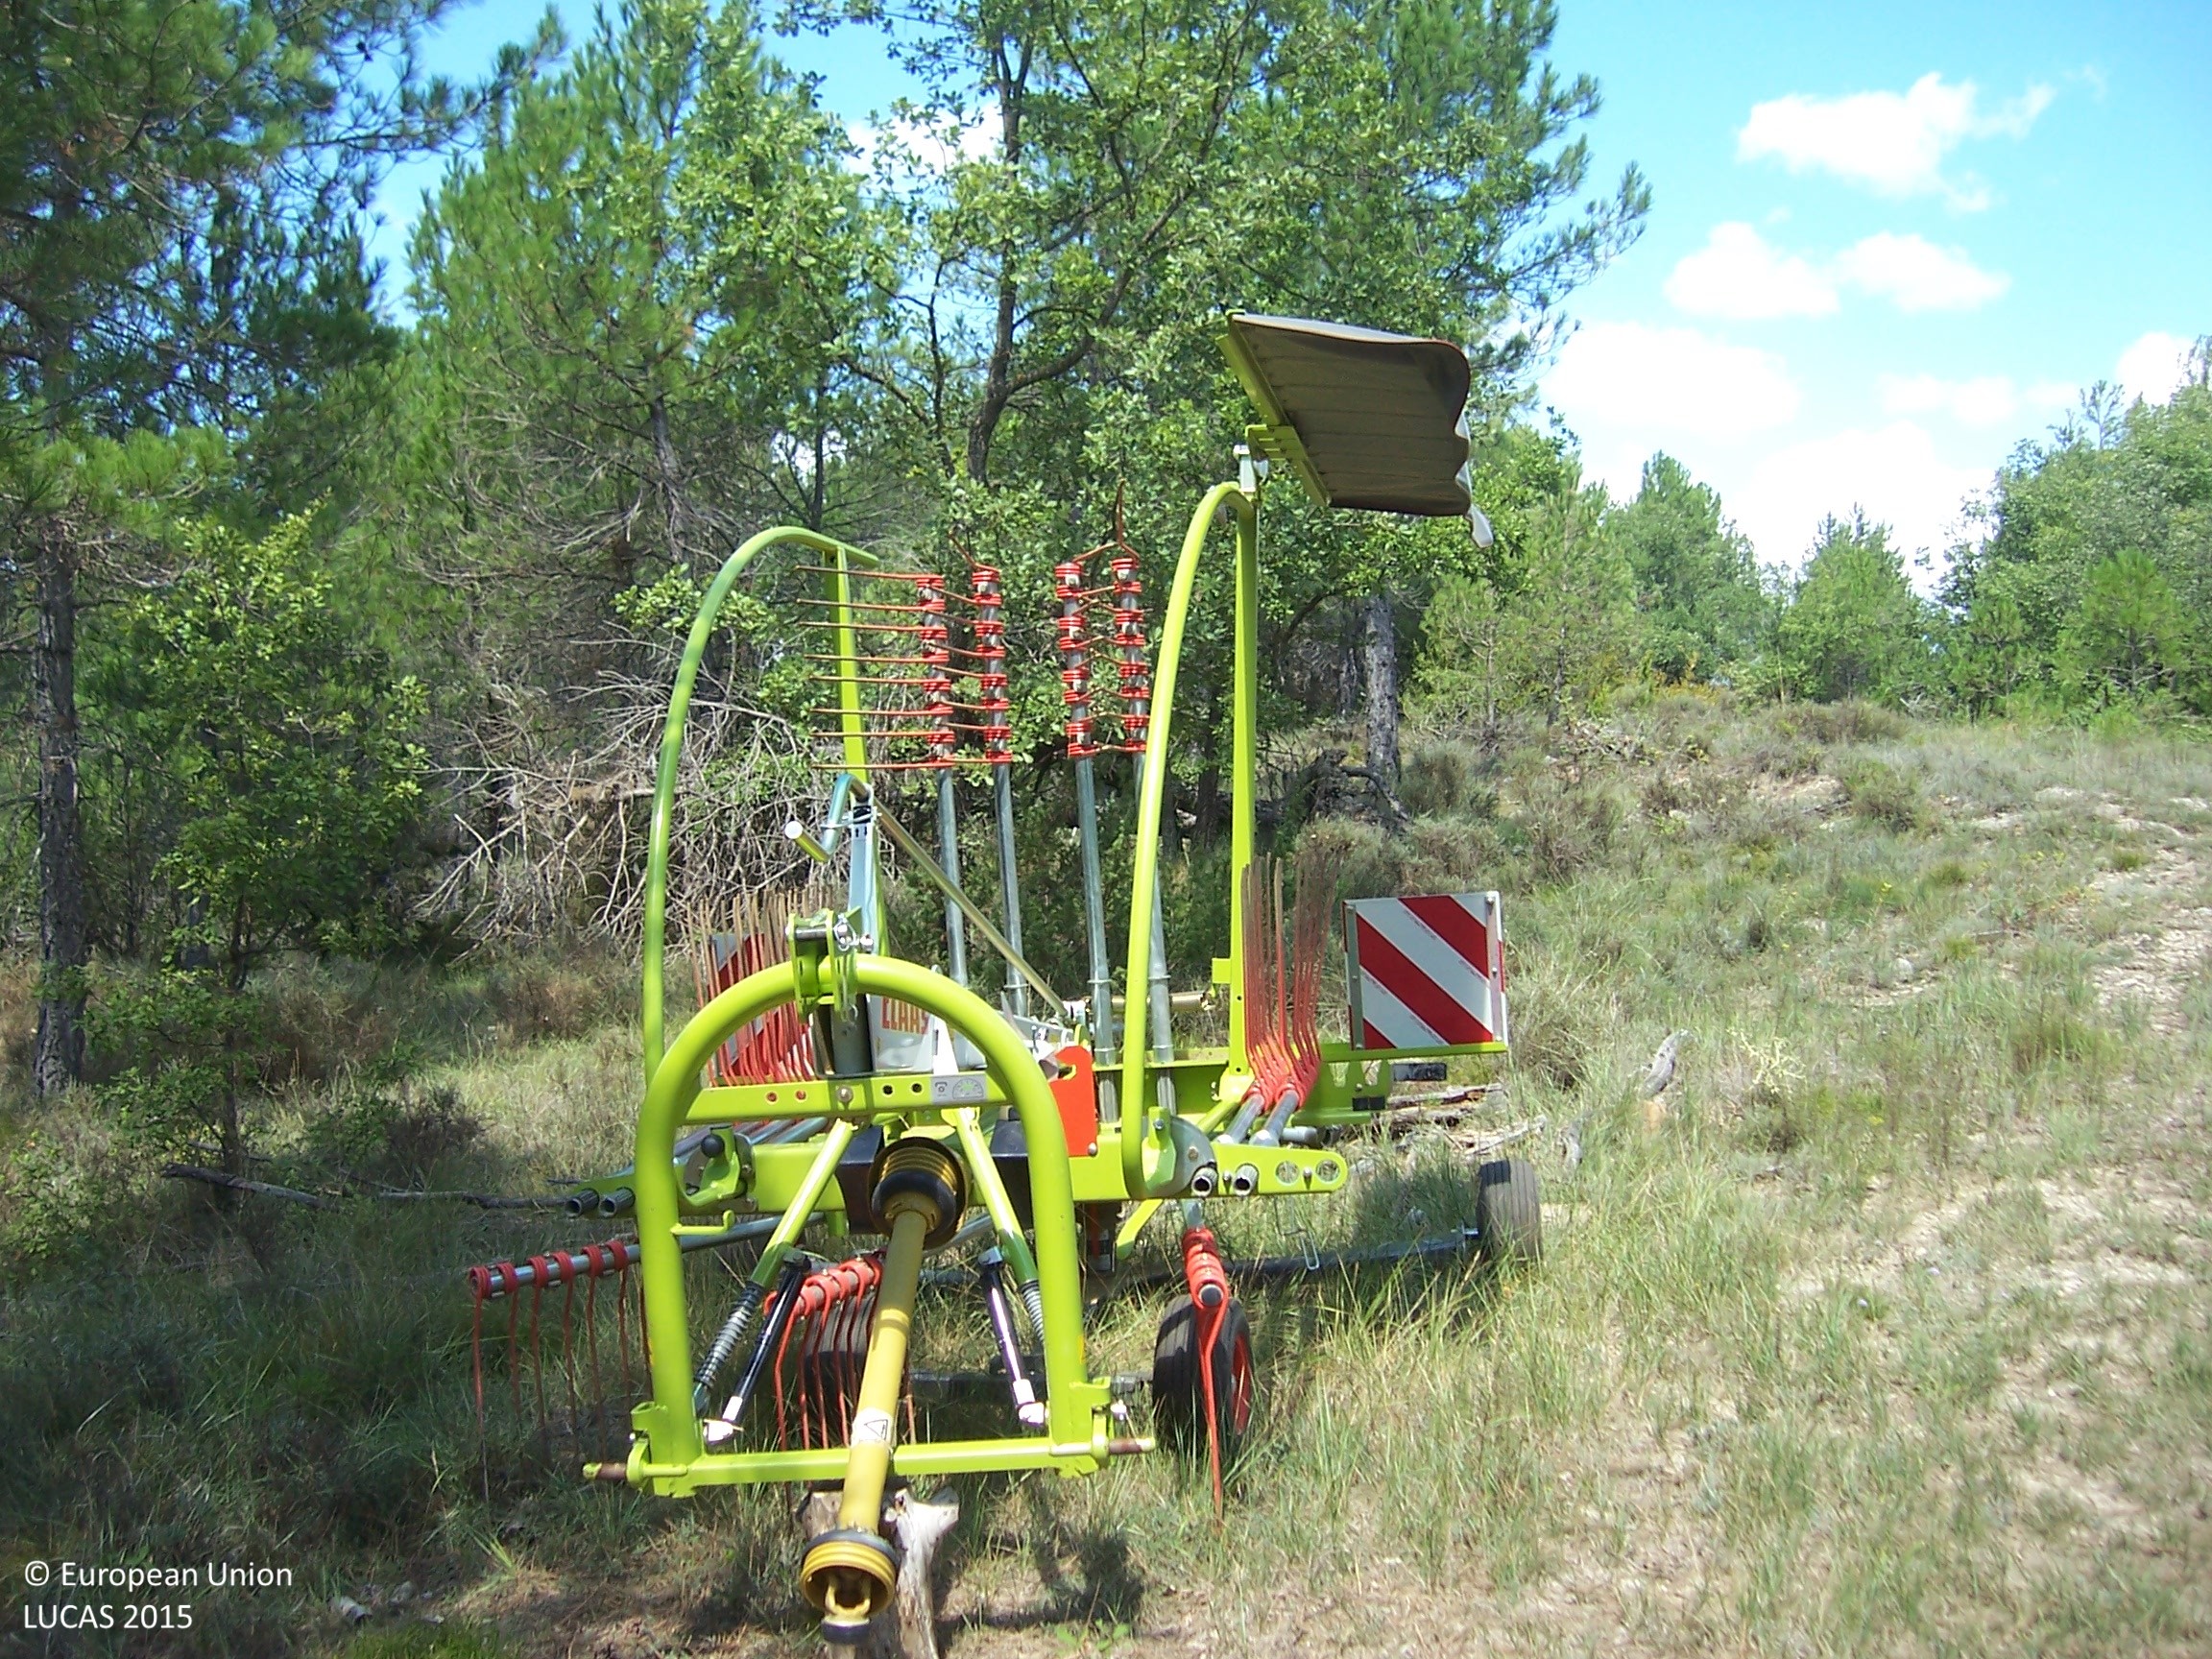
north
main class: Woodland
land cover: Pine dominated mixed woodland
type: coniferous forest of the mediterranean region
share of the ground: > 75 %
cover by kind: coniferous forest trees 30 %, herbaceous plants 30 %, unconsolidated bare surface 20 %, broadleaved forest trees 10 %, shrubs 10 %
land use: Semi-natural and natural areas not in use
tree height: > 5 m
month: August
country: ES
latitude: 42.3290
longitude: 0.2597
